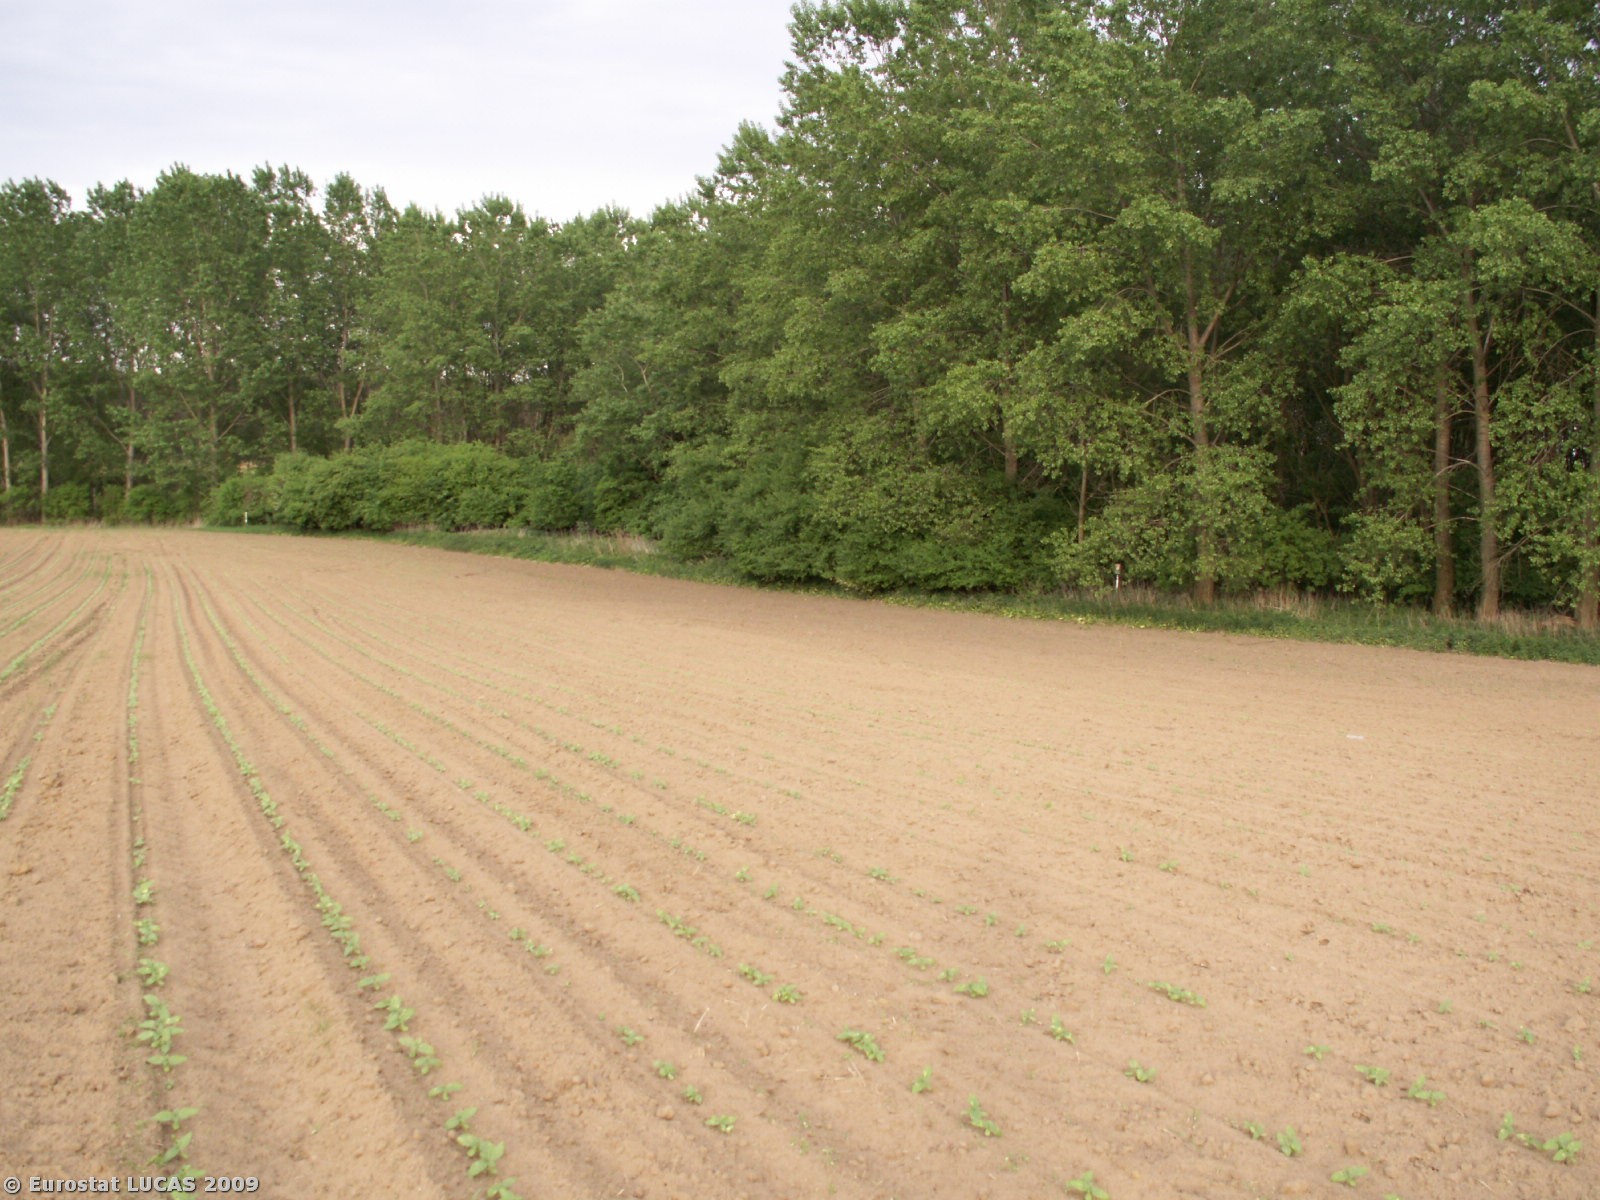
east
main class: Cropland
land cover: Sunflower
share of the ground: < 10 %
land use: Agriculture (excluding fallow land and kitchen gardens)
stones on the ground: < 10 %
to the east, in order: Sunflower; Grass margins; Broadleaved woodland; Grassland without tree/shrub cover; Broadleaved woodland; Grassland without tree/shrub cover; Bare land
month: May
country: CZ
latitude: 48.9663
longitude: 17.1536
